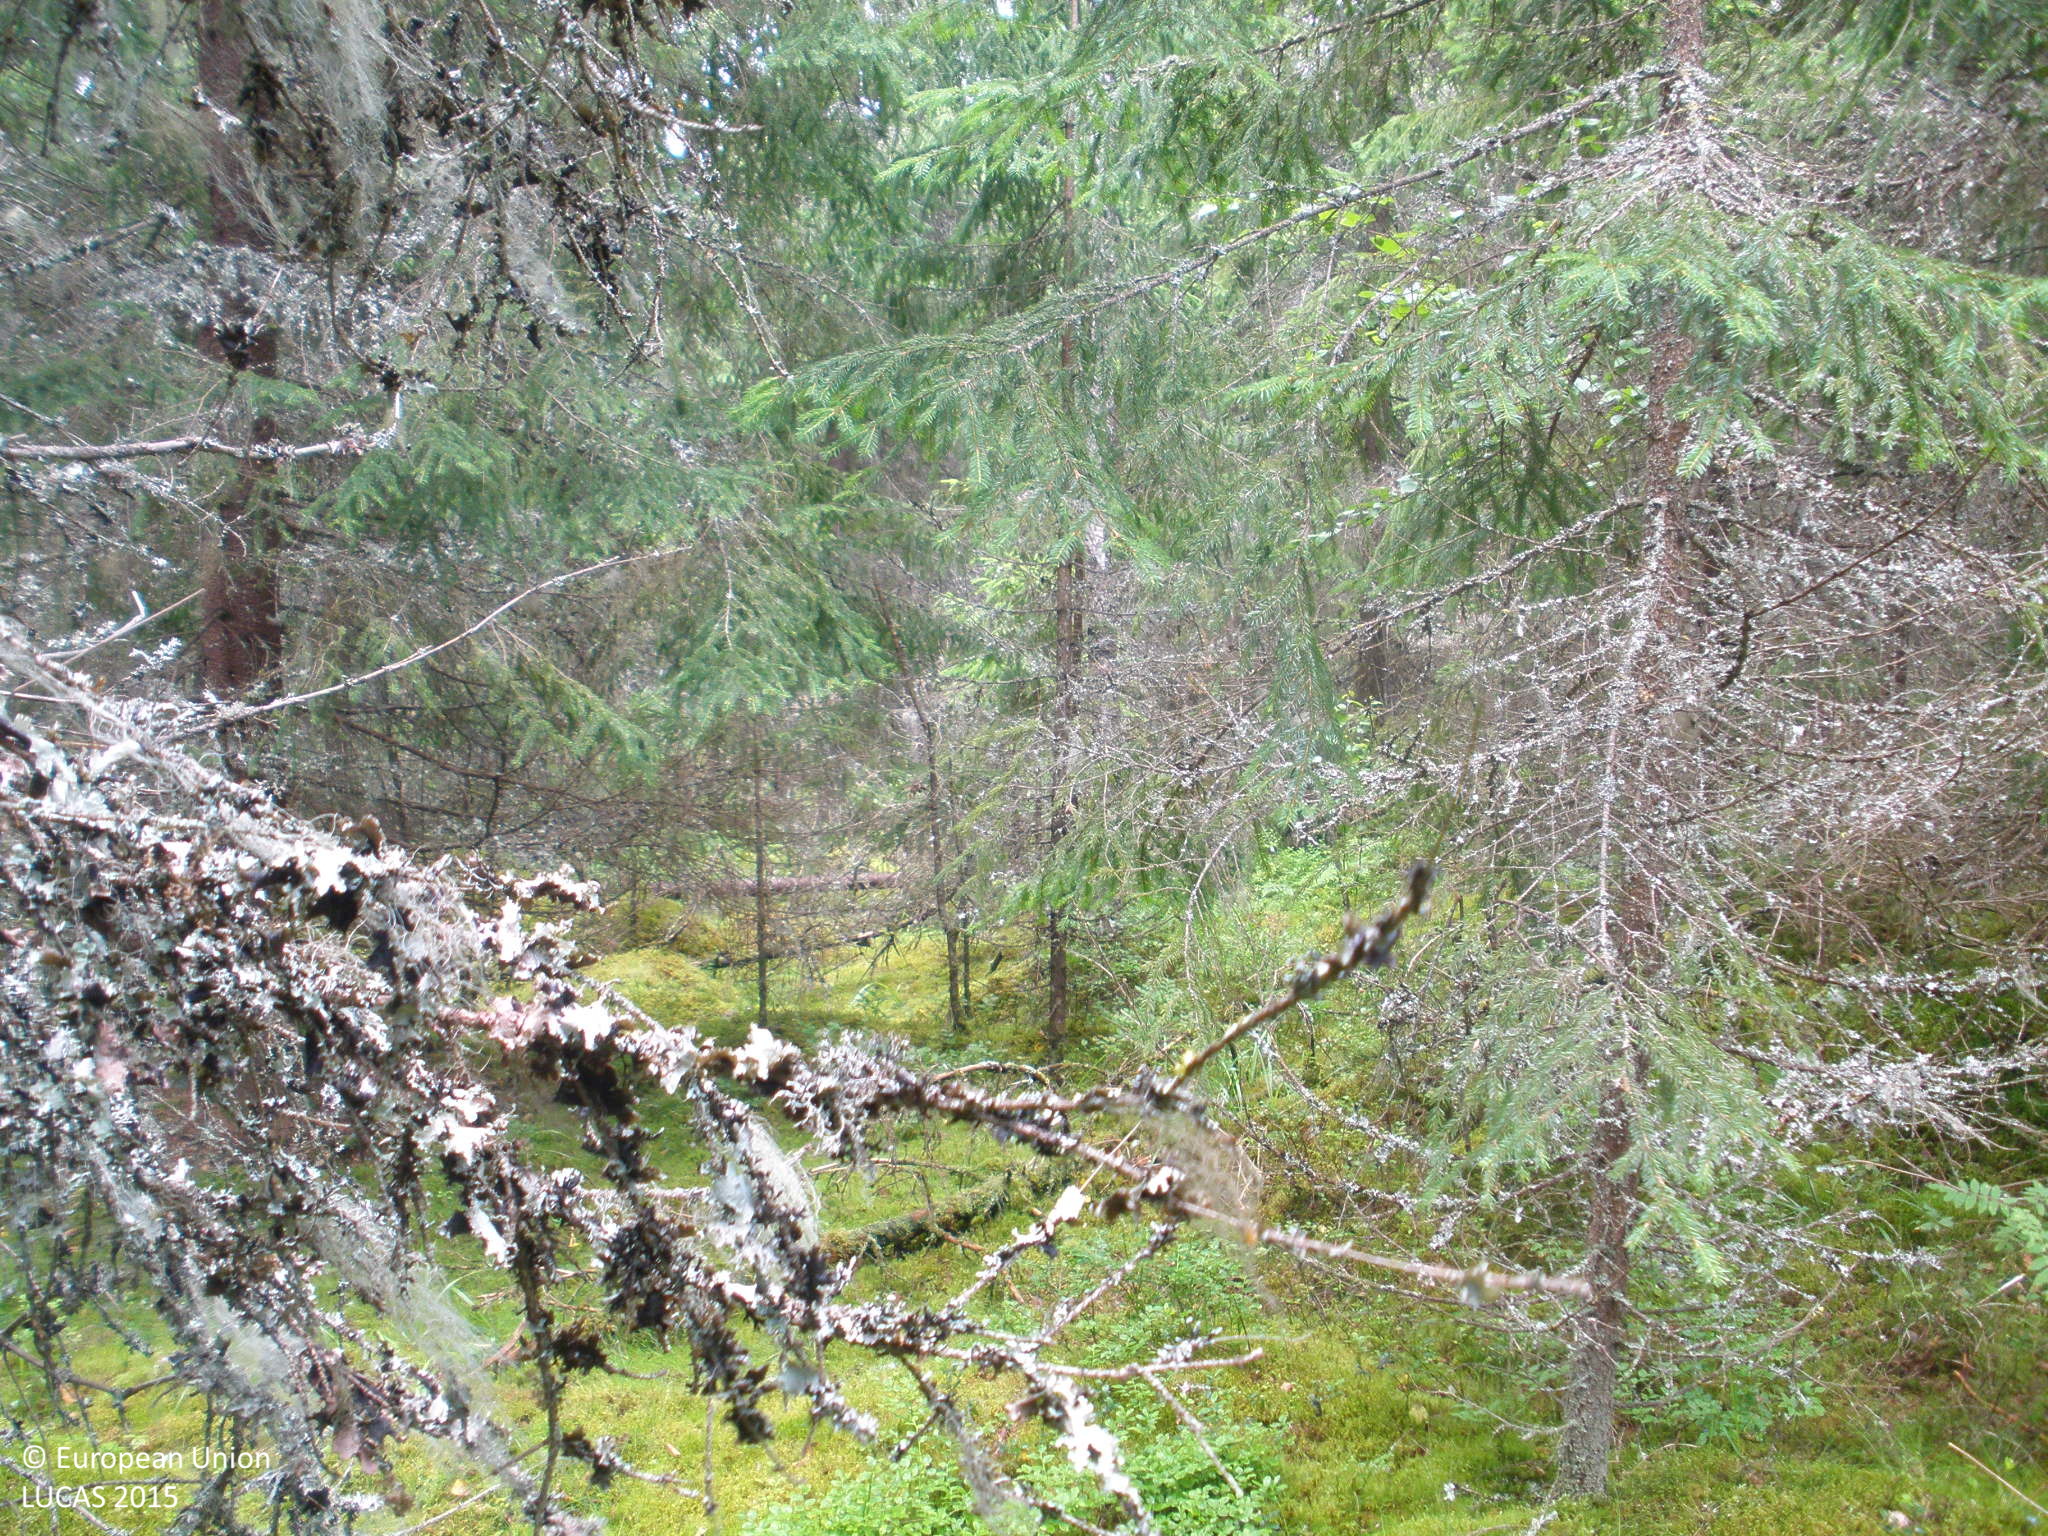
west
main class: Woodland
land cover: Spruce dominated coniferous woodland
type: boreal forest
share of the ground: > 75 %
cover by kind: coniferous forest trees 80 %, lichens and mosses 10 %, broadleaved forest trees 5 %, herbaceous plants 5 %
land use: Forestry
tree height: > 5 m
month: July
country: FI
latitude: 60.9902
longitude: 24.9940
